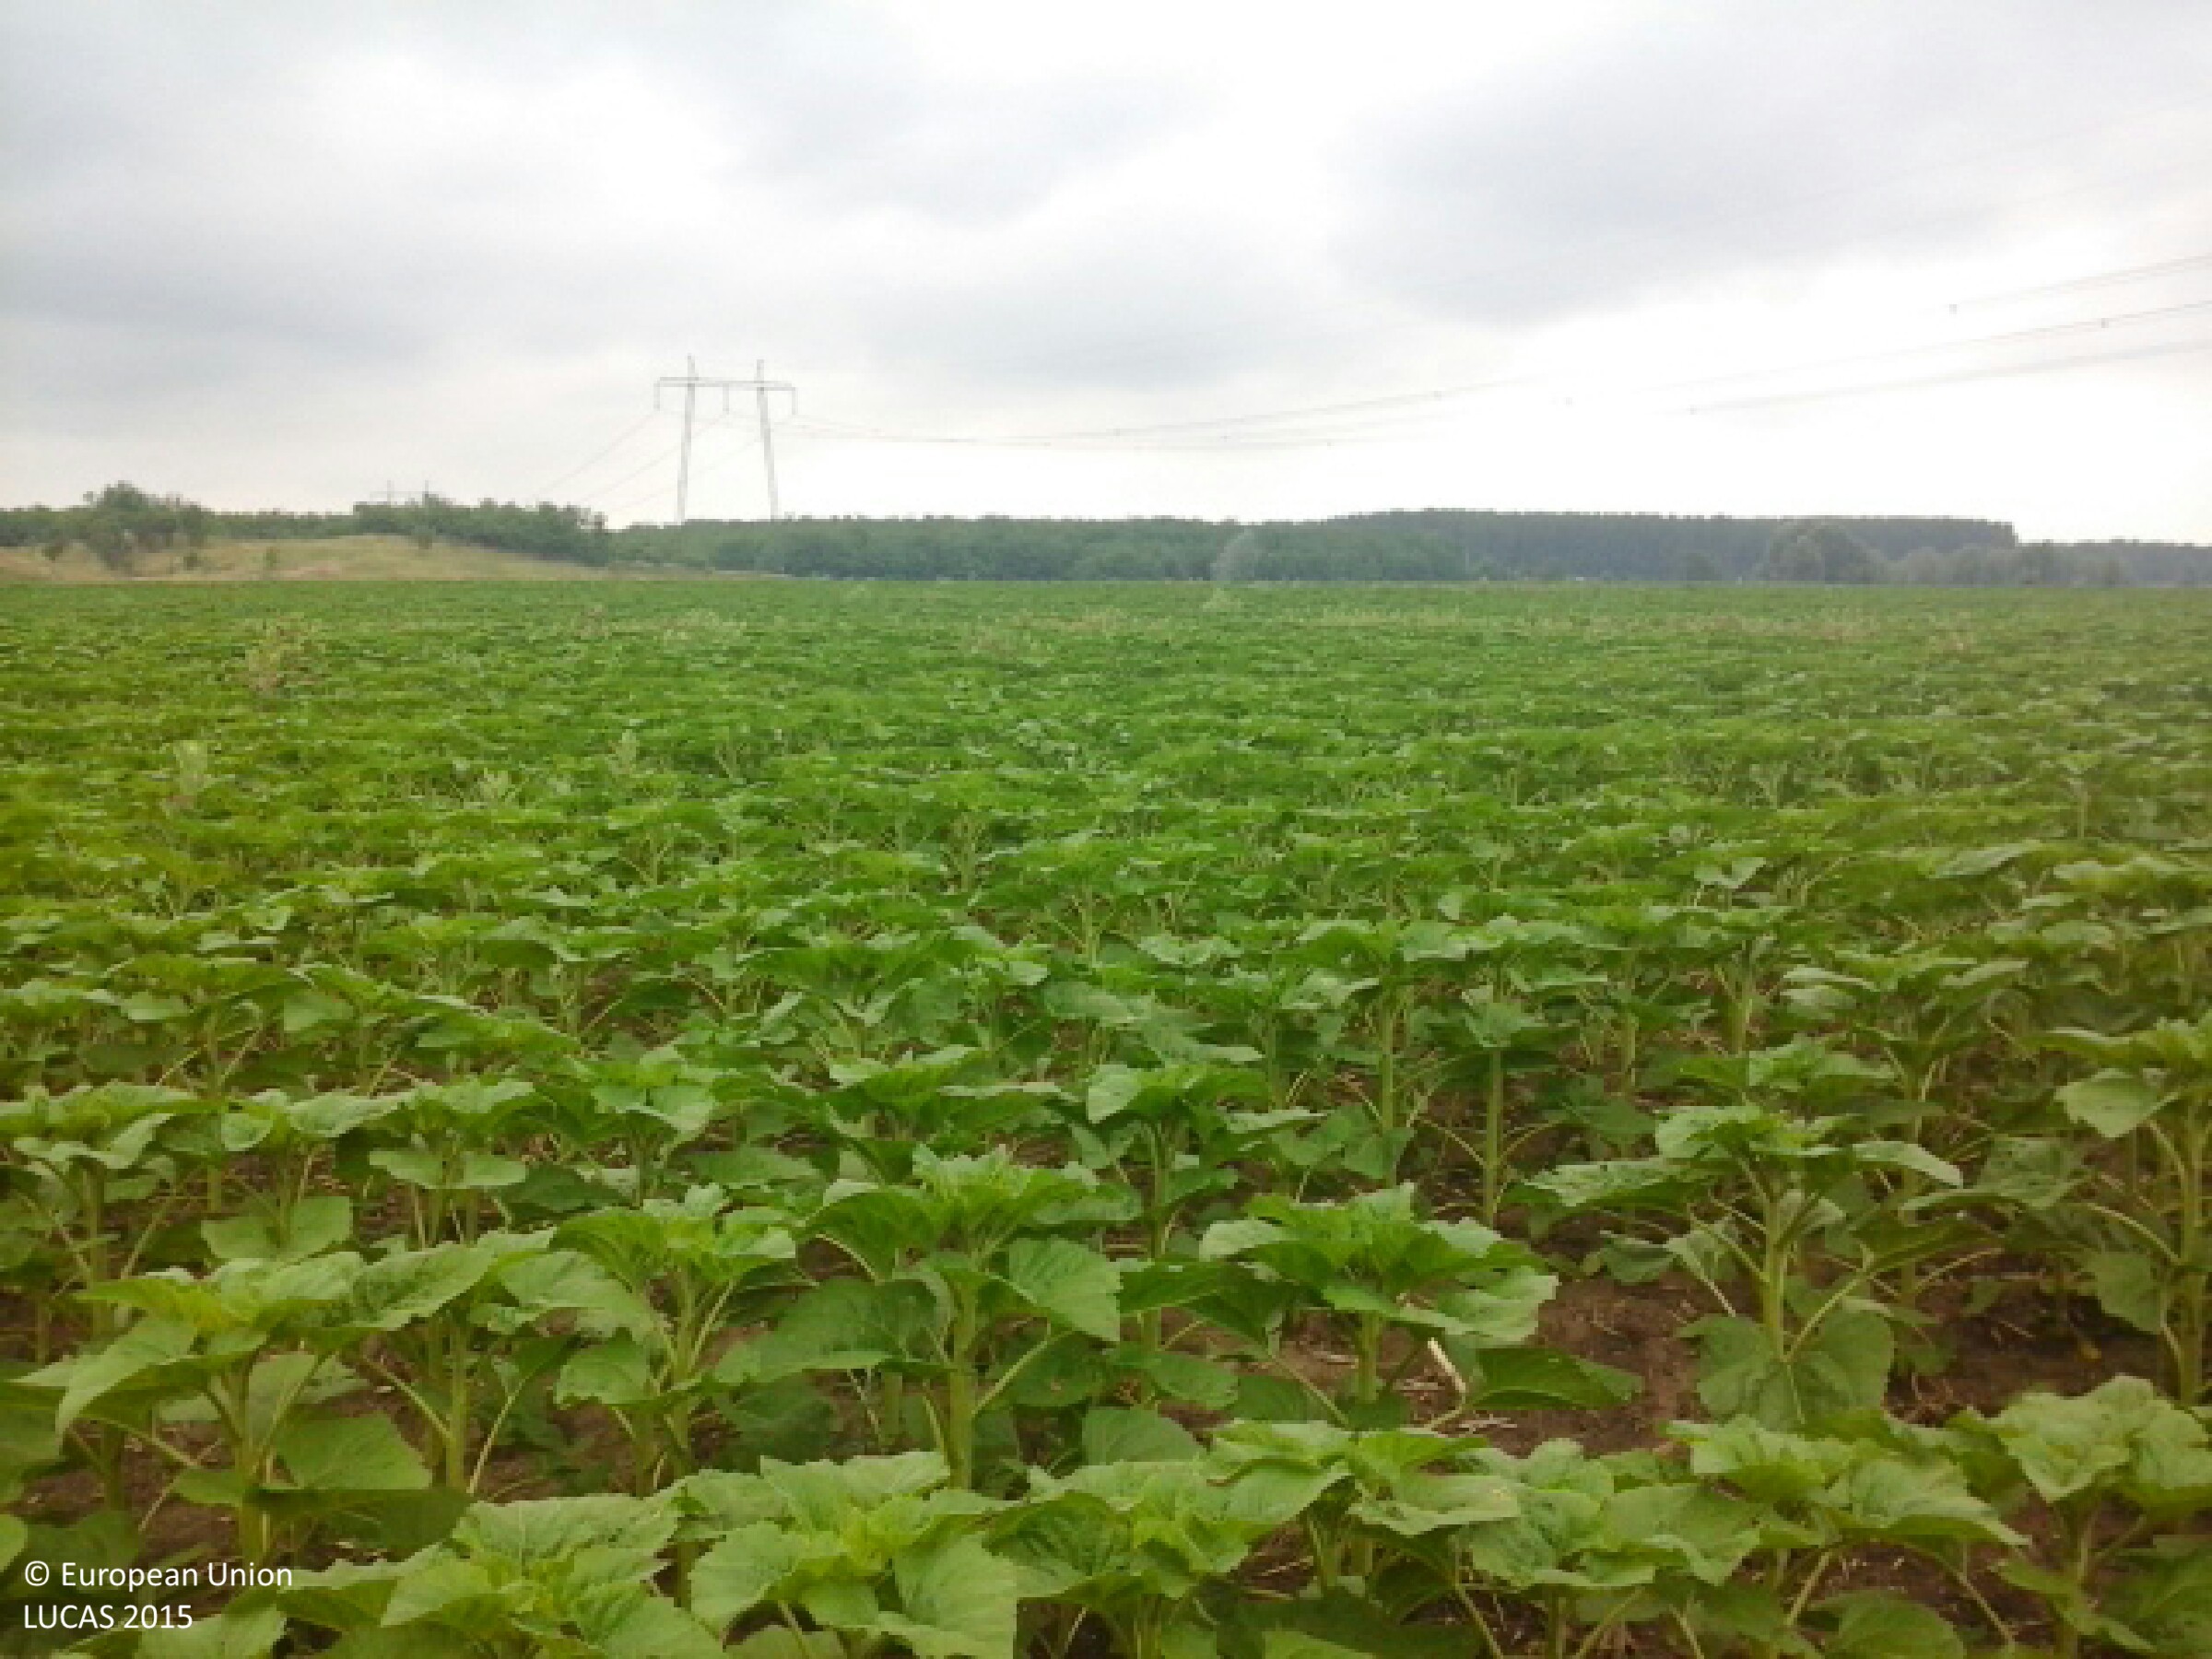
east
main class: Cropland
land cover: Sunflower
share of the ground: 50 - 75 %
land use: Agriculture (excluding fallow land and kitchen gardens)
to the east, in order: Sunflower
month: June
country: HU
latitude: 48.0937
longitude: 21.8253
